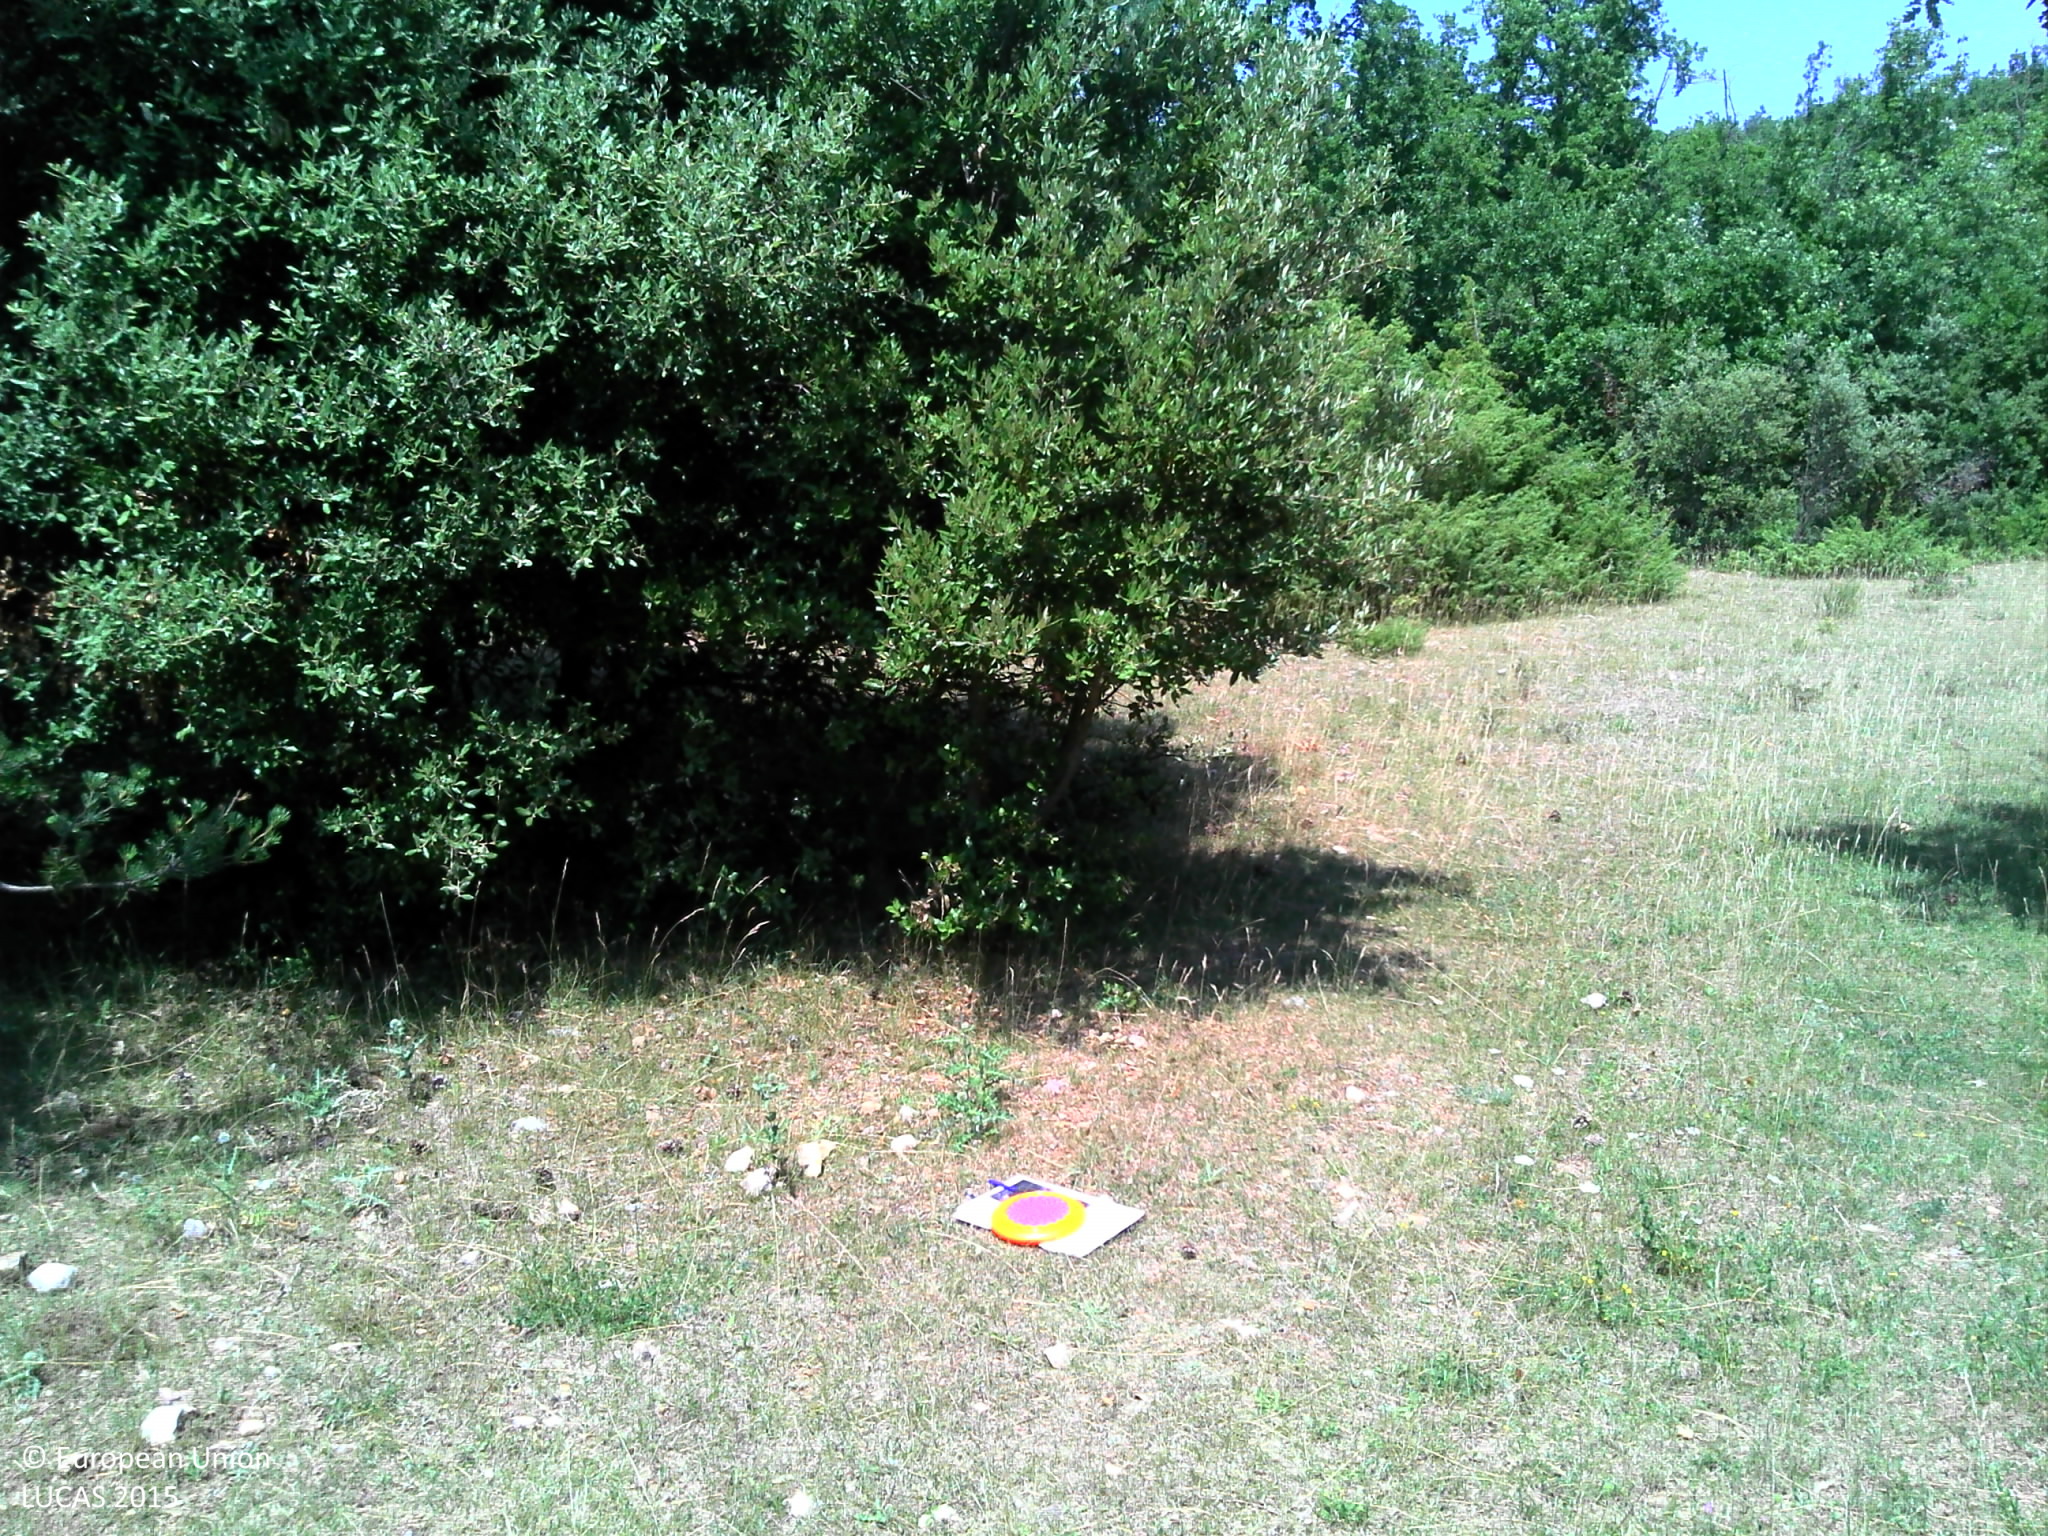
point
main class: Woodland
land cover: Broadleaved woodland
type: broadleaved evergreen forest
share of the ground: 50 - 75 %
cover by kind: herbaceous plants 45 %, broadleaved forest trees 40 %, shrubs 10 %, coniferous forest trees 5 %
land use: Agriculture (excluding fallow land and kitchen gardens)
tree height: > 5 m
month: July
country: FR
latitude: 44.0095
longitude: 5.3061
